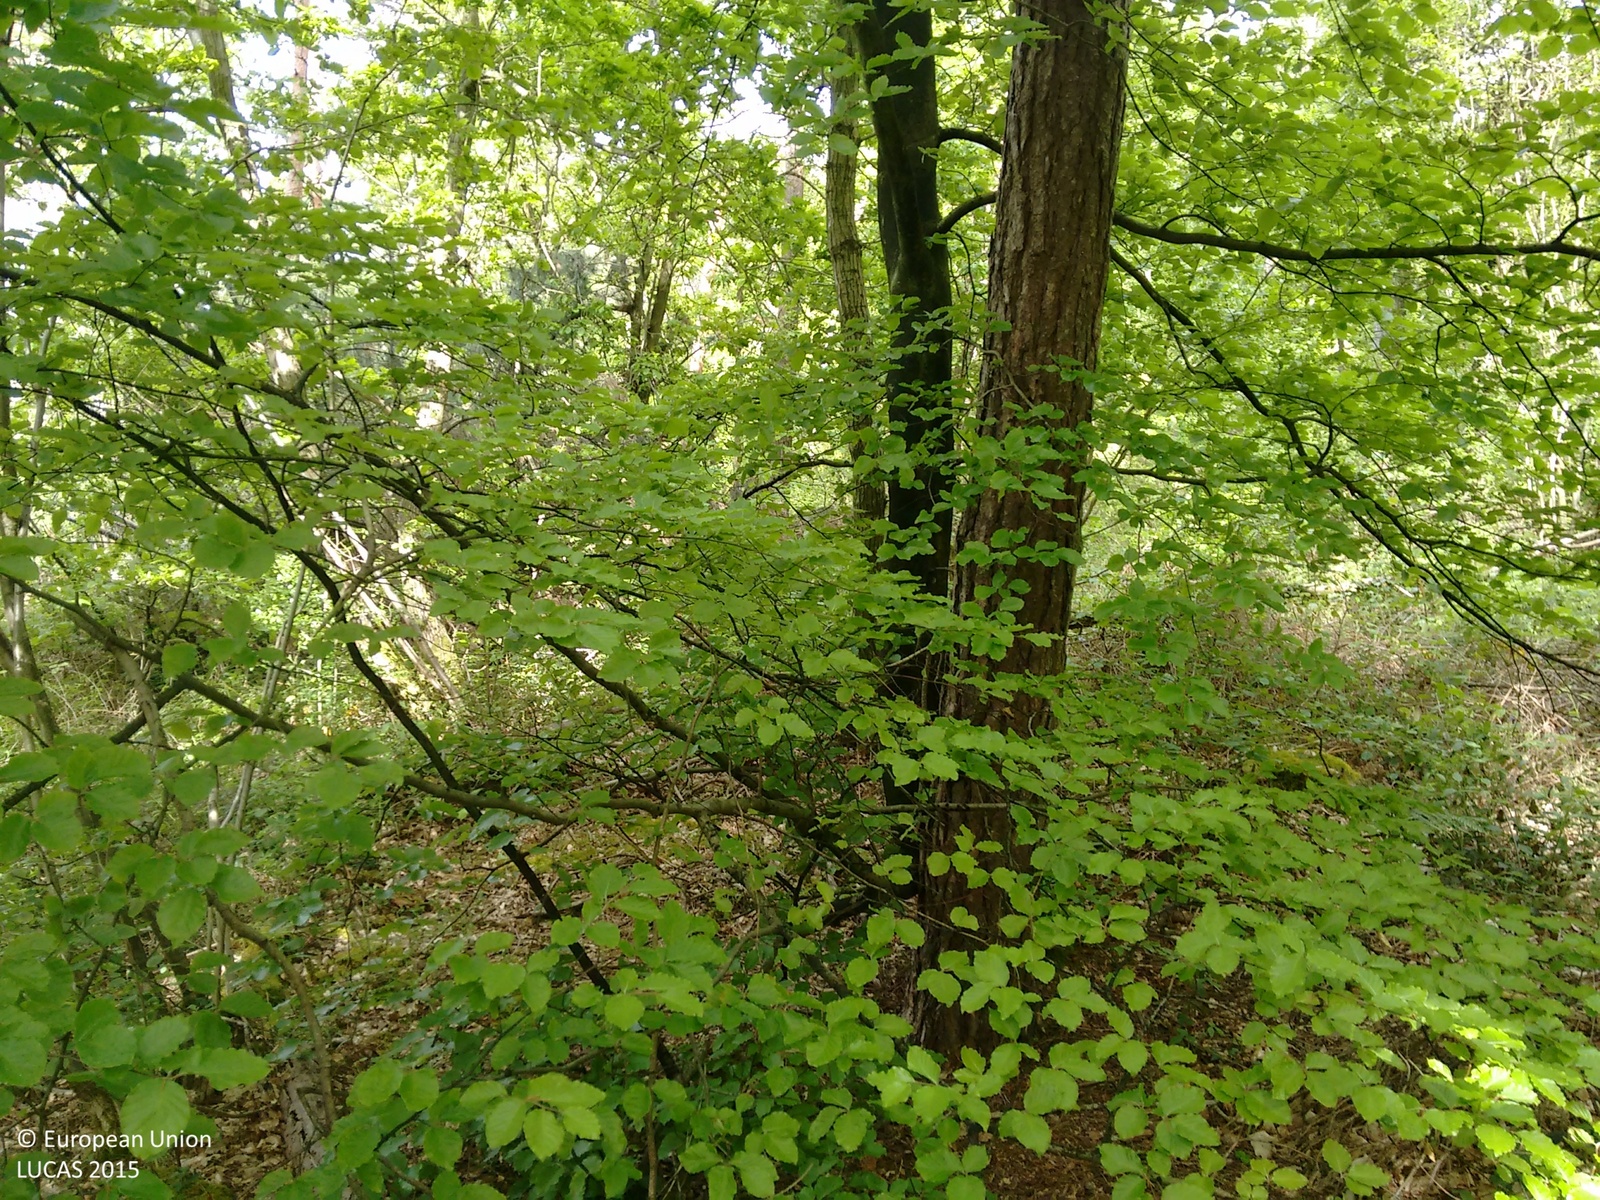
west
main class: Woodland
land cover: Other mixed woodland
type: hemiboreal forest and nemoral coniferous forest and mixed broadleaved-coniferous forest
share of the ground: > 75 %
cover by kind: coniferous forest trees 50 %, broadleaved forest trees 50 %
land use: Forestry
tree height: > 5 m
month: May
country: GB
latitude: 50.7244
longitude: -1.3388
